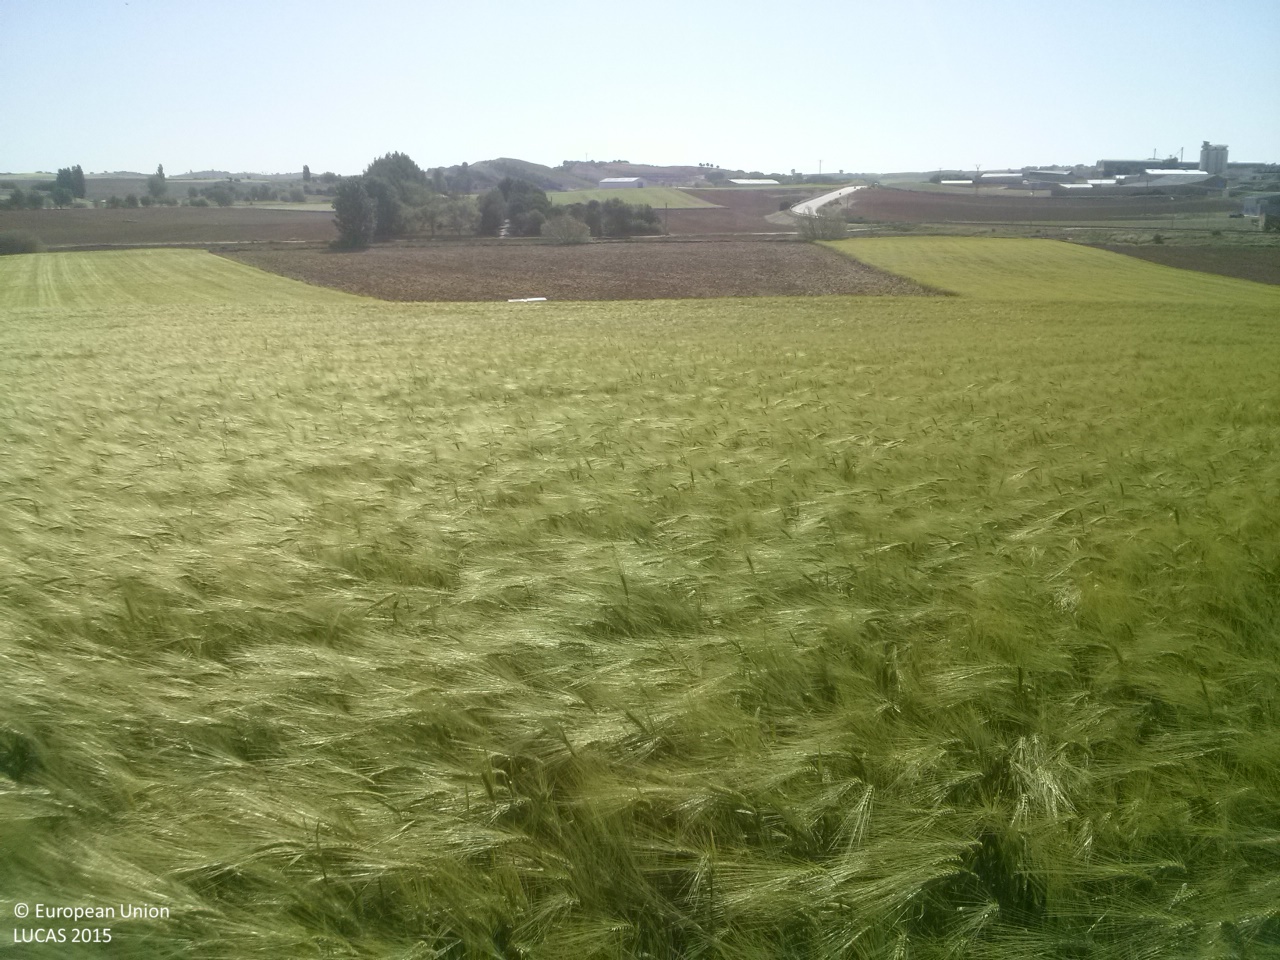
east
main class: Cropland
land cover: Barley
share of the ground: > 75 %
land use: Agriculture (excluding fallow land and kitchen gardens)
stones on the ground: < 10 %
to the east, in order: Barley; Grass margins; Tracks; Grass margins; Other bare soil; Rivers and streams; Grass margins; Other bare soil
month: May
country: ES
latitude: 39.8472
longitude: -2.5103
